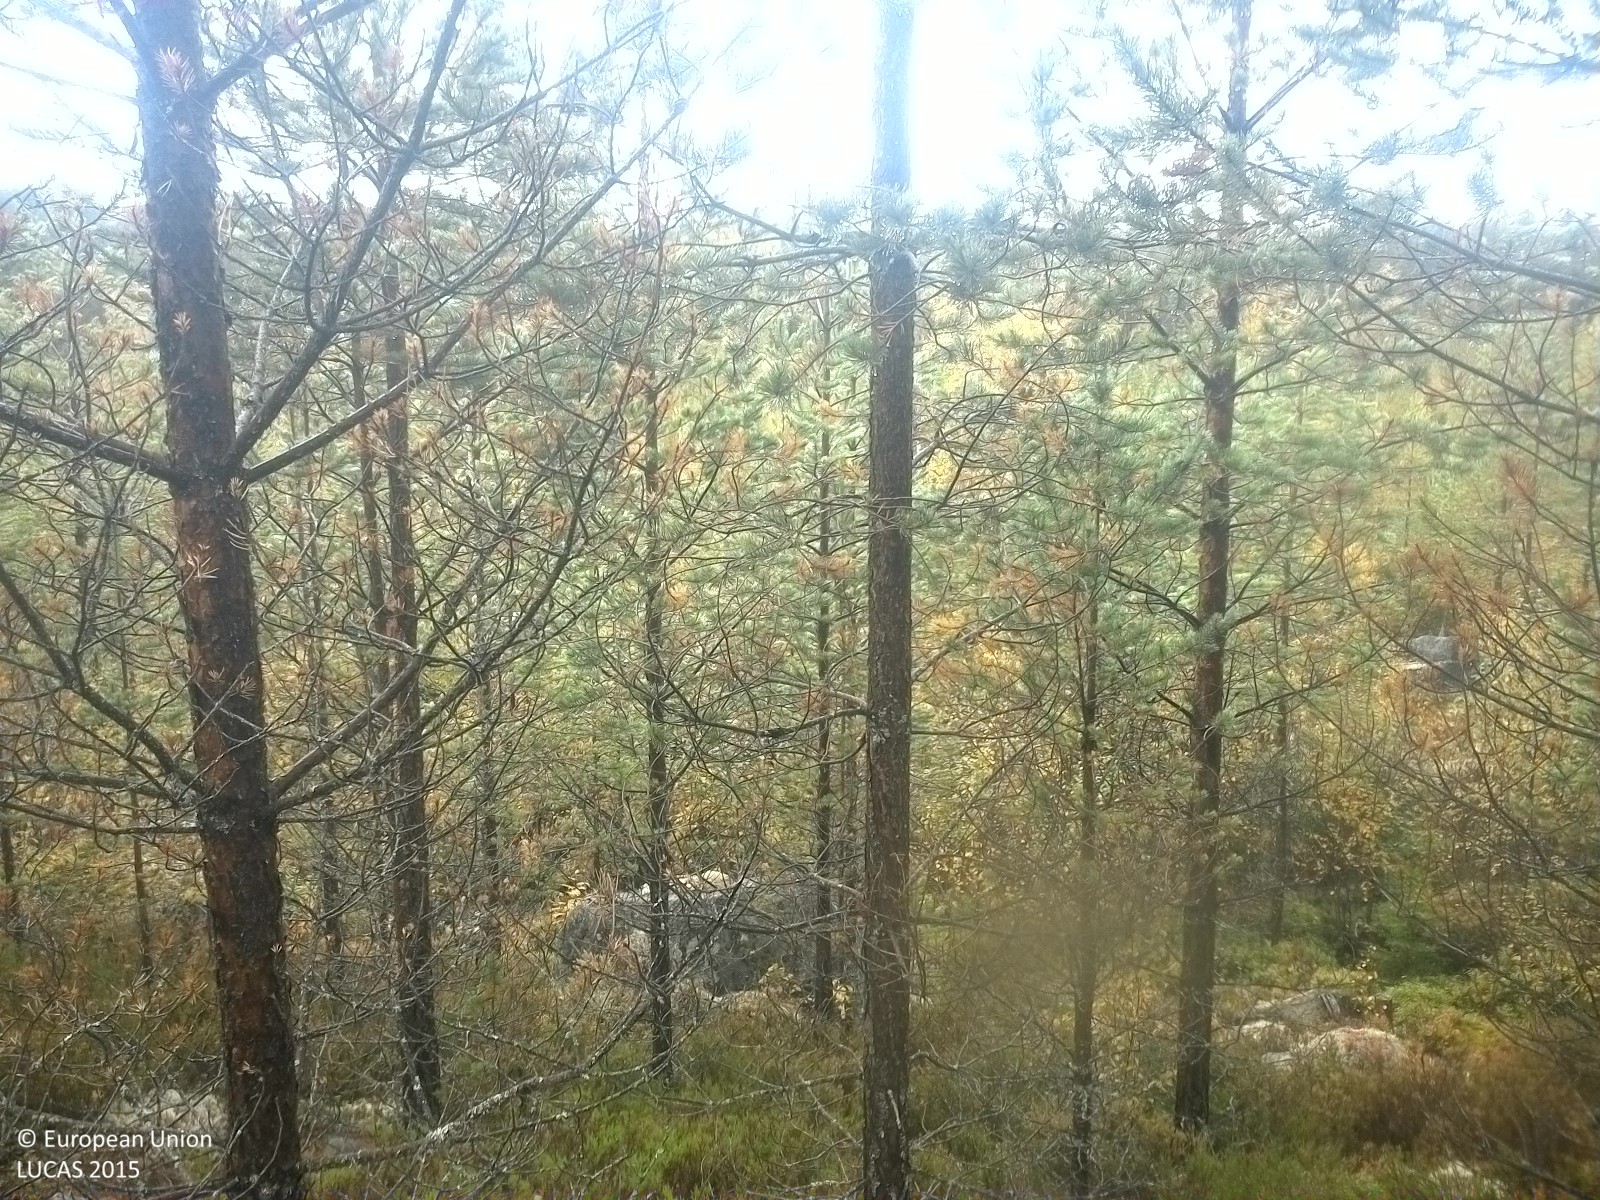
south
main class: Woodland
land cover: Pine dominated coniferous woodland
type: boreal forest
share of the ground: 25 - 50 %
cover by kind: shrubs 40 %, coniferous forest trees 35 %, lichens and mosses 20 %, broadleaved forest trees 5 %
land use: Forestry
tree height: > 5 m
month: September
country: SE
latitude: 62.1466
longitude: 15.6027
